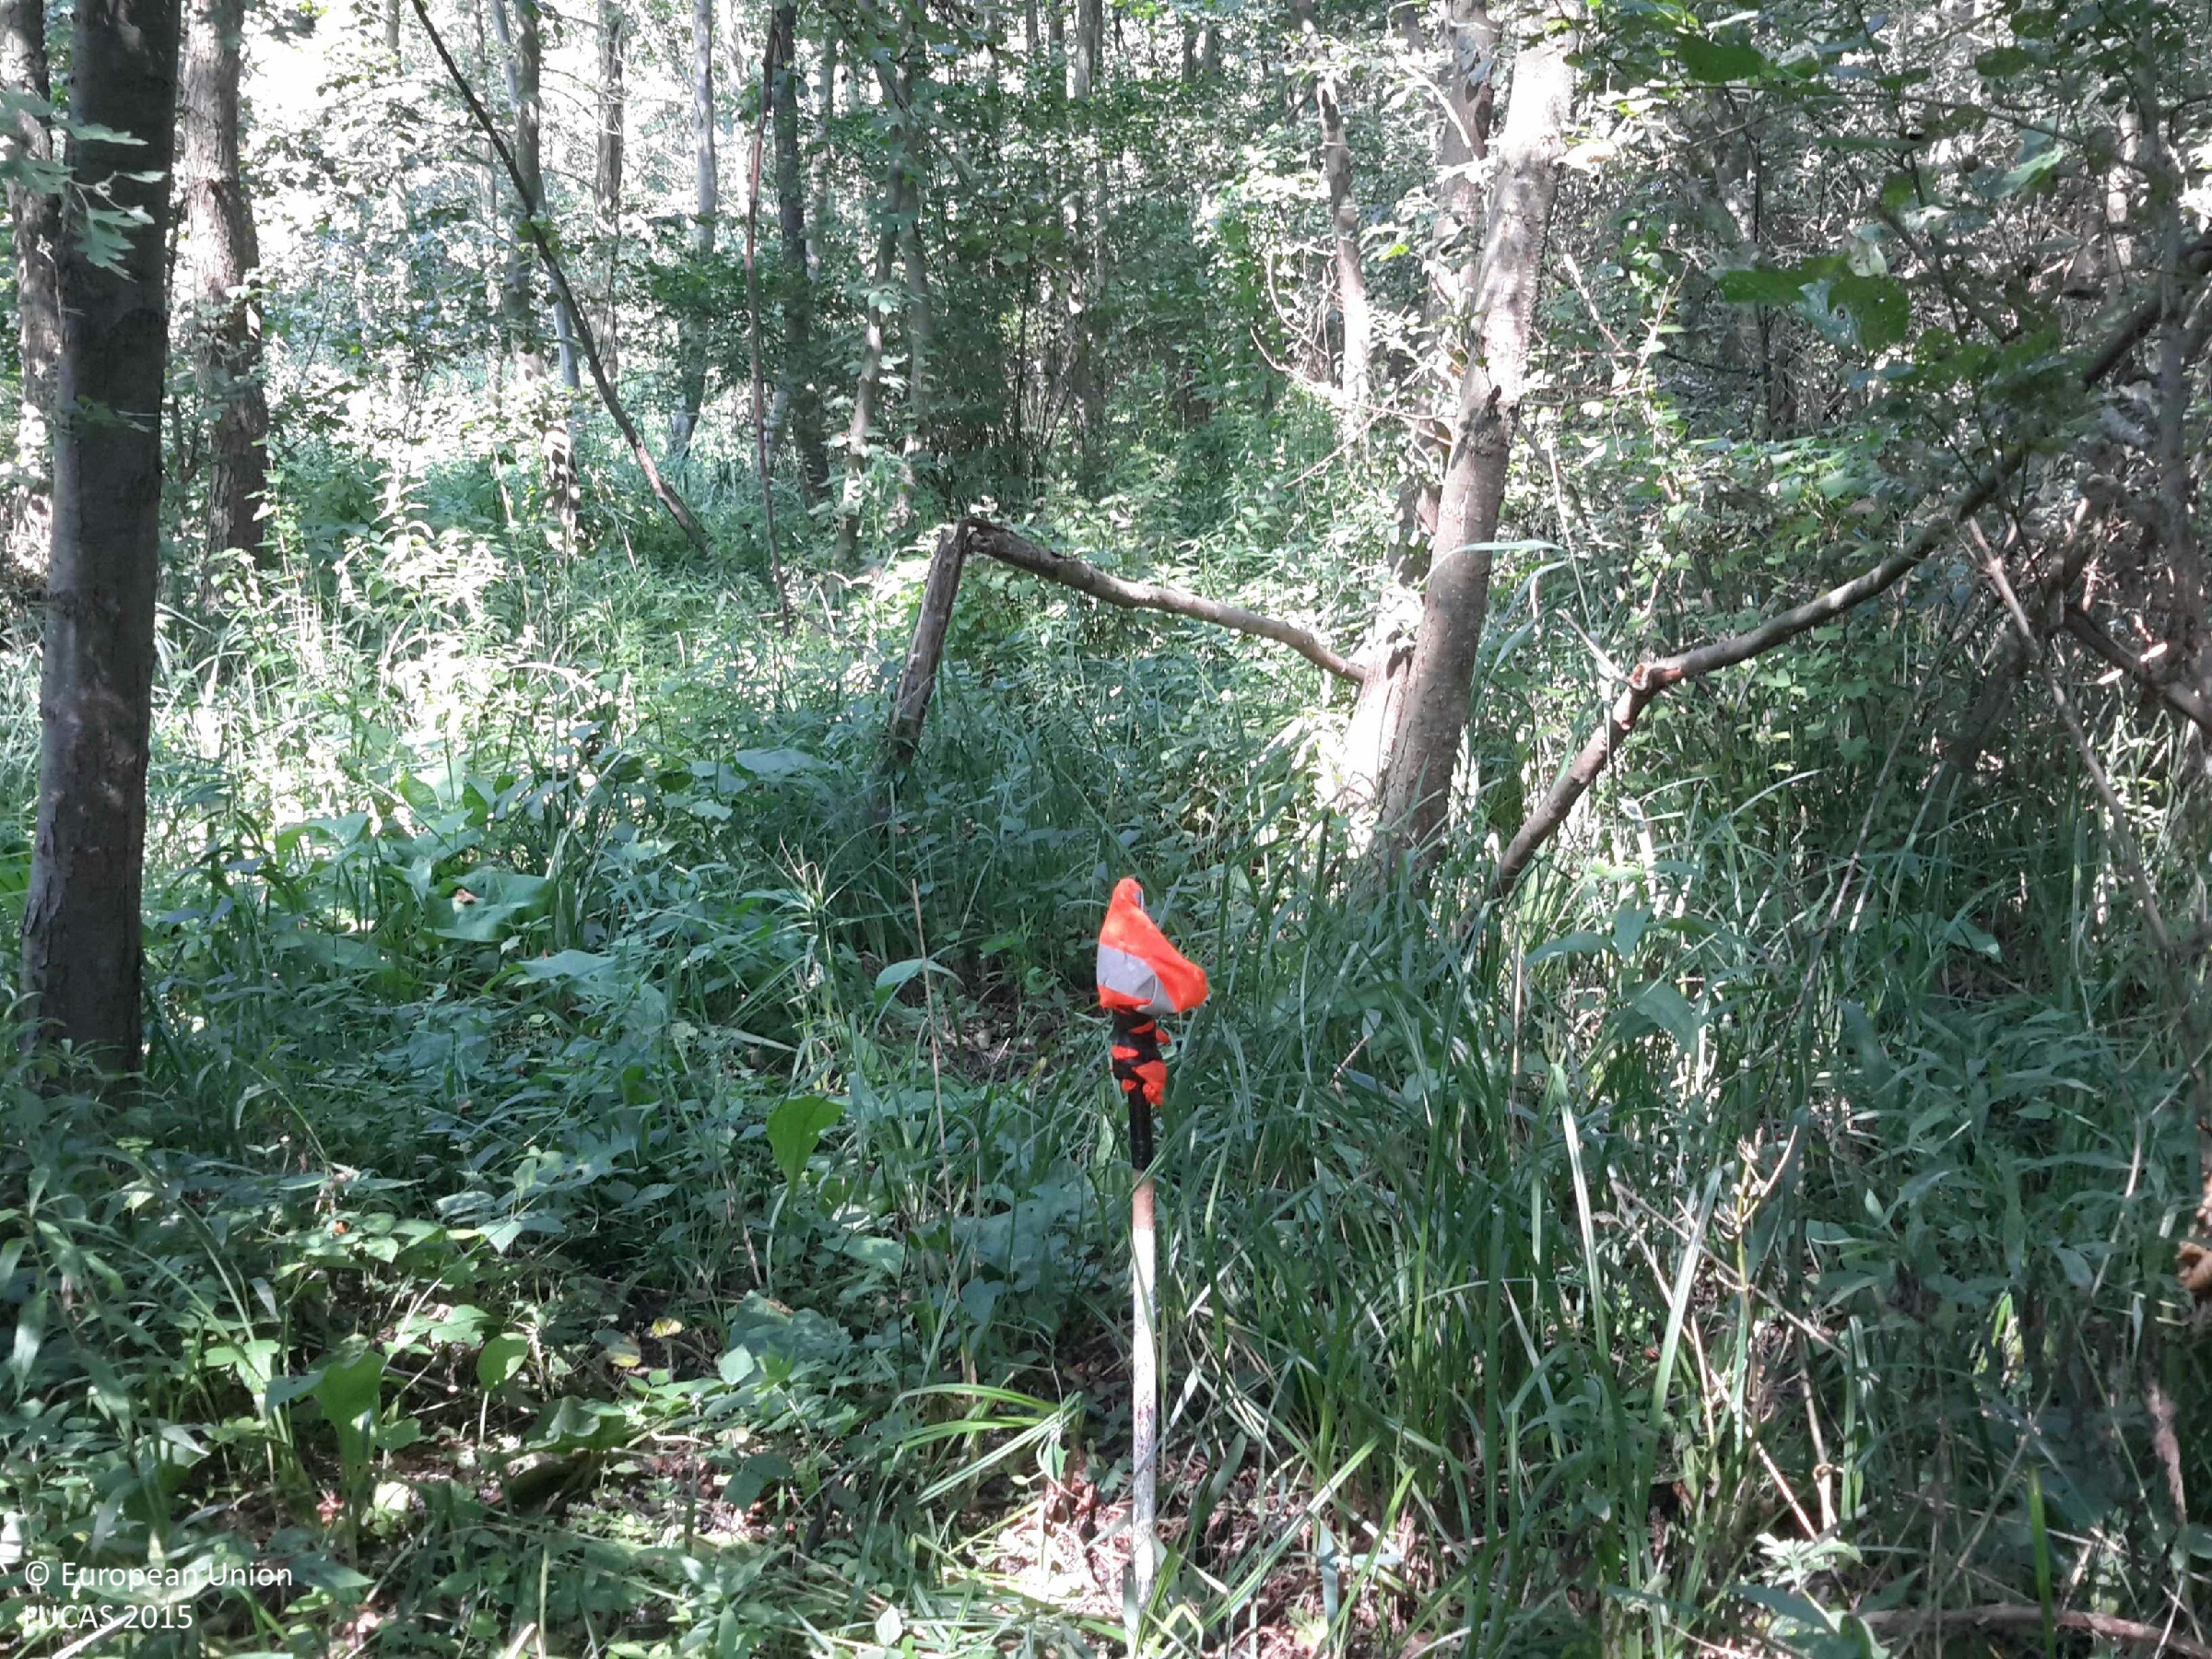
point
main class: Woodland
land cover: Broadleaved woodland
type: mesophytic deciduous forest
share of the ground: > 75 %
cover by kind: broadleaved forest trees 90 %, herbaceous plants 10 %
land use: Forestry
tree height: > 5 m
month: August
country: HU
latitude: 47.8017
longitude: 17.2845
